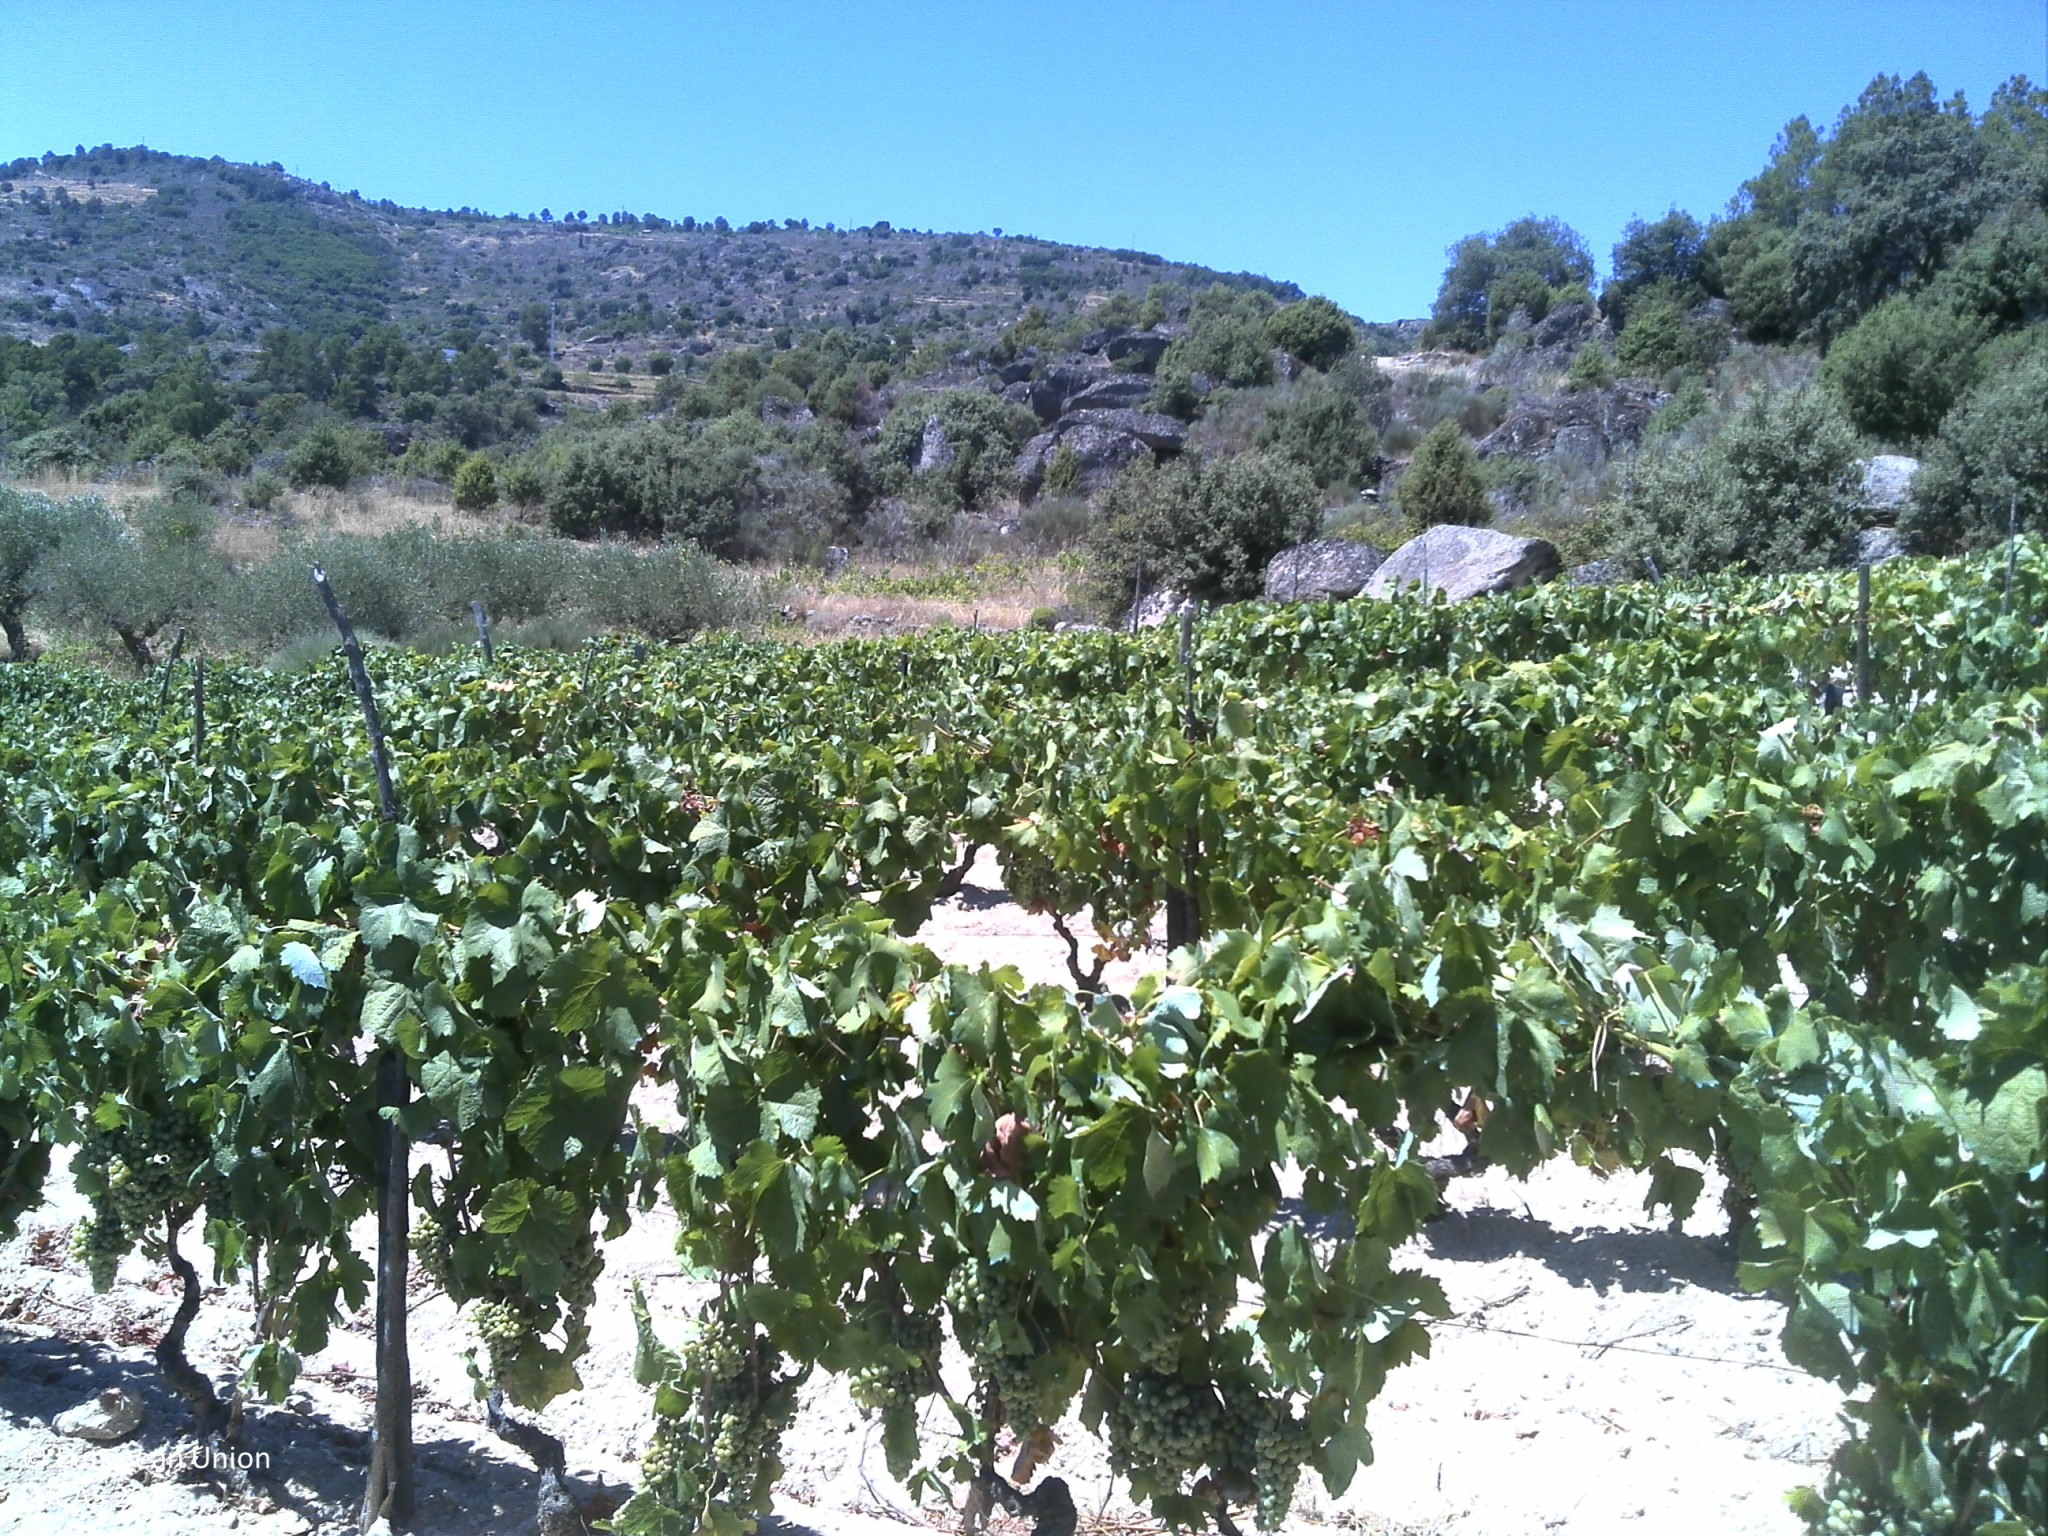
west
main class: Cropland
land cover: Vineyards
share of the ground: 10 - 25 %
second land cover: Other bare soil
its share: > 75 %
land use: Agriculture (excluding fallow land and kitchen gardens)
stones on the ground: 25 - 50 %
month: July
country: PT
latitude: 41.1963
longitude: -7.1529
